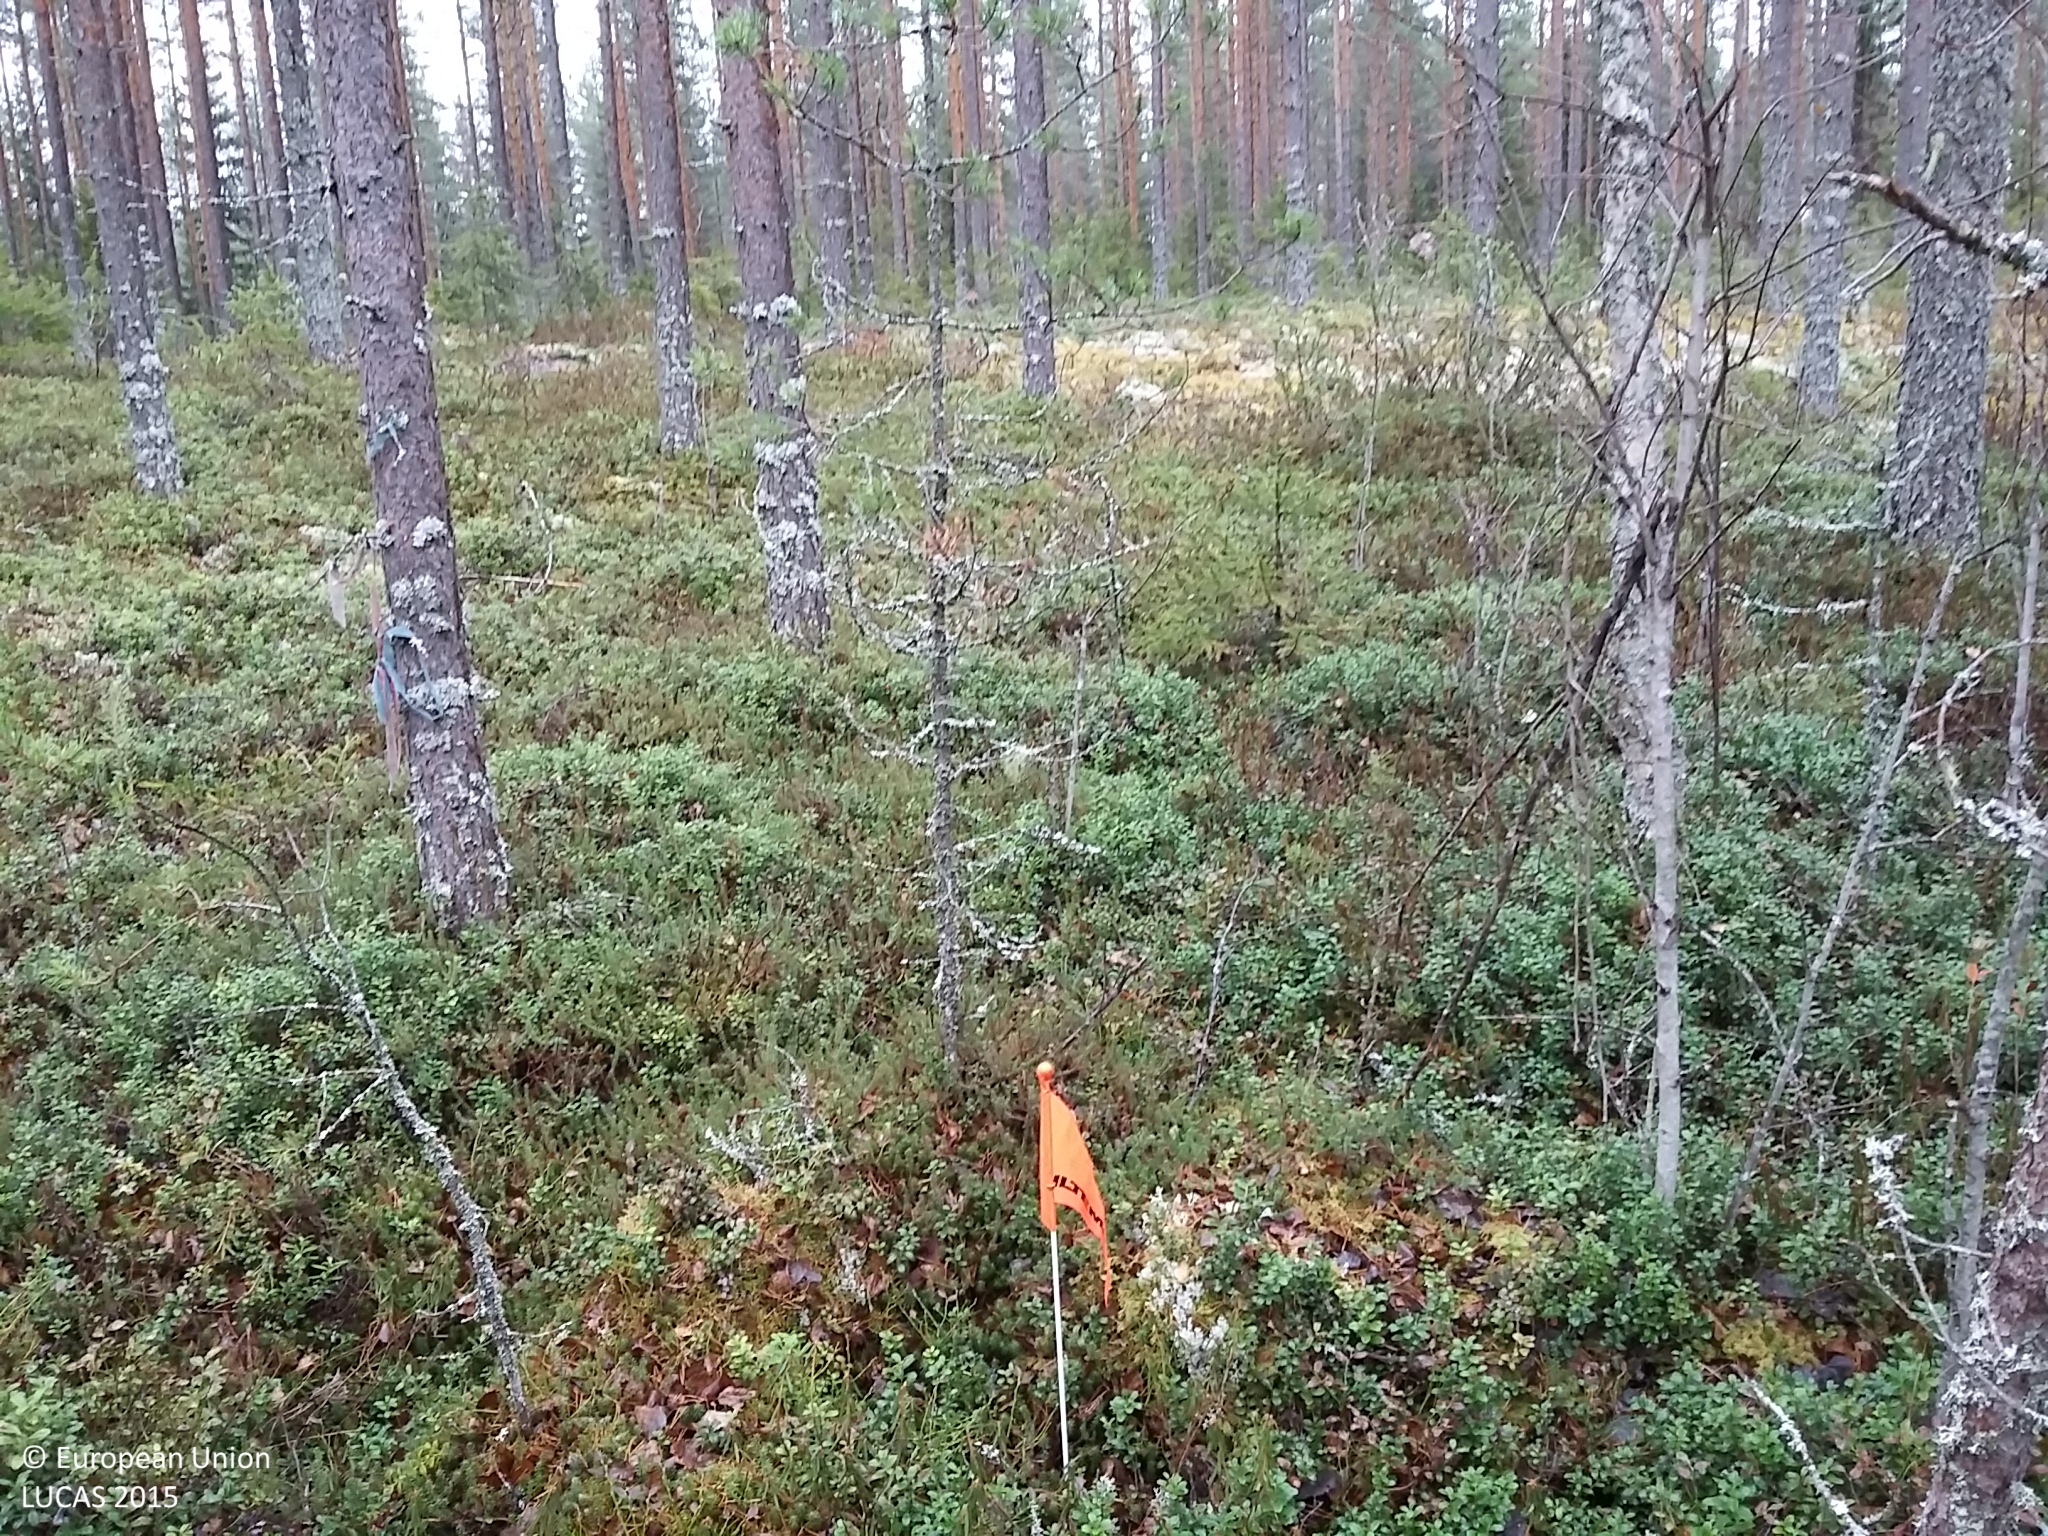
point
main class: Woodland
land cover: Pine dominated coniferous woodland
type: boreal forest
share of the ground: > 75 %
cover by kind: coniferous forest trees 65 %, shrubs 15 %, broadleaved forest trees 10 %, lichens and mosses 10 %
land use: Forestry
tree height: > 5 m
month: October
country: FI
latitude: 64.4214
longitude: 25.3452
